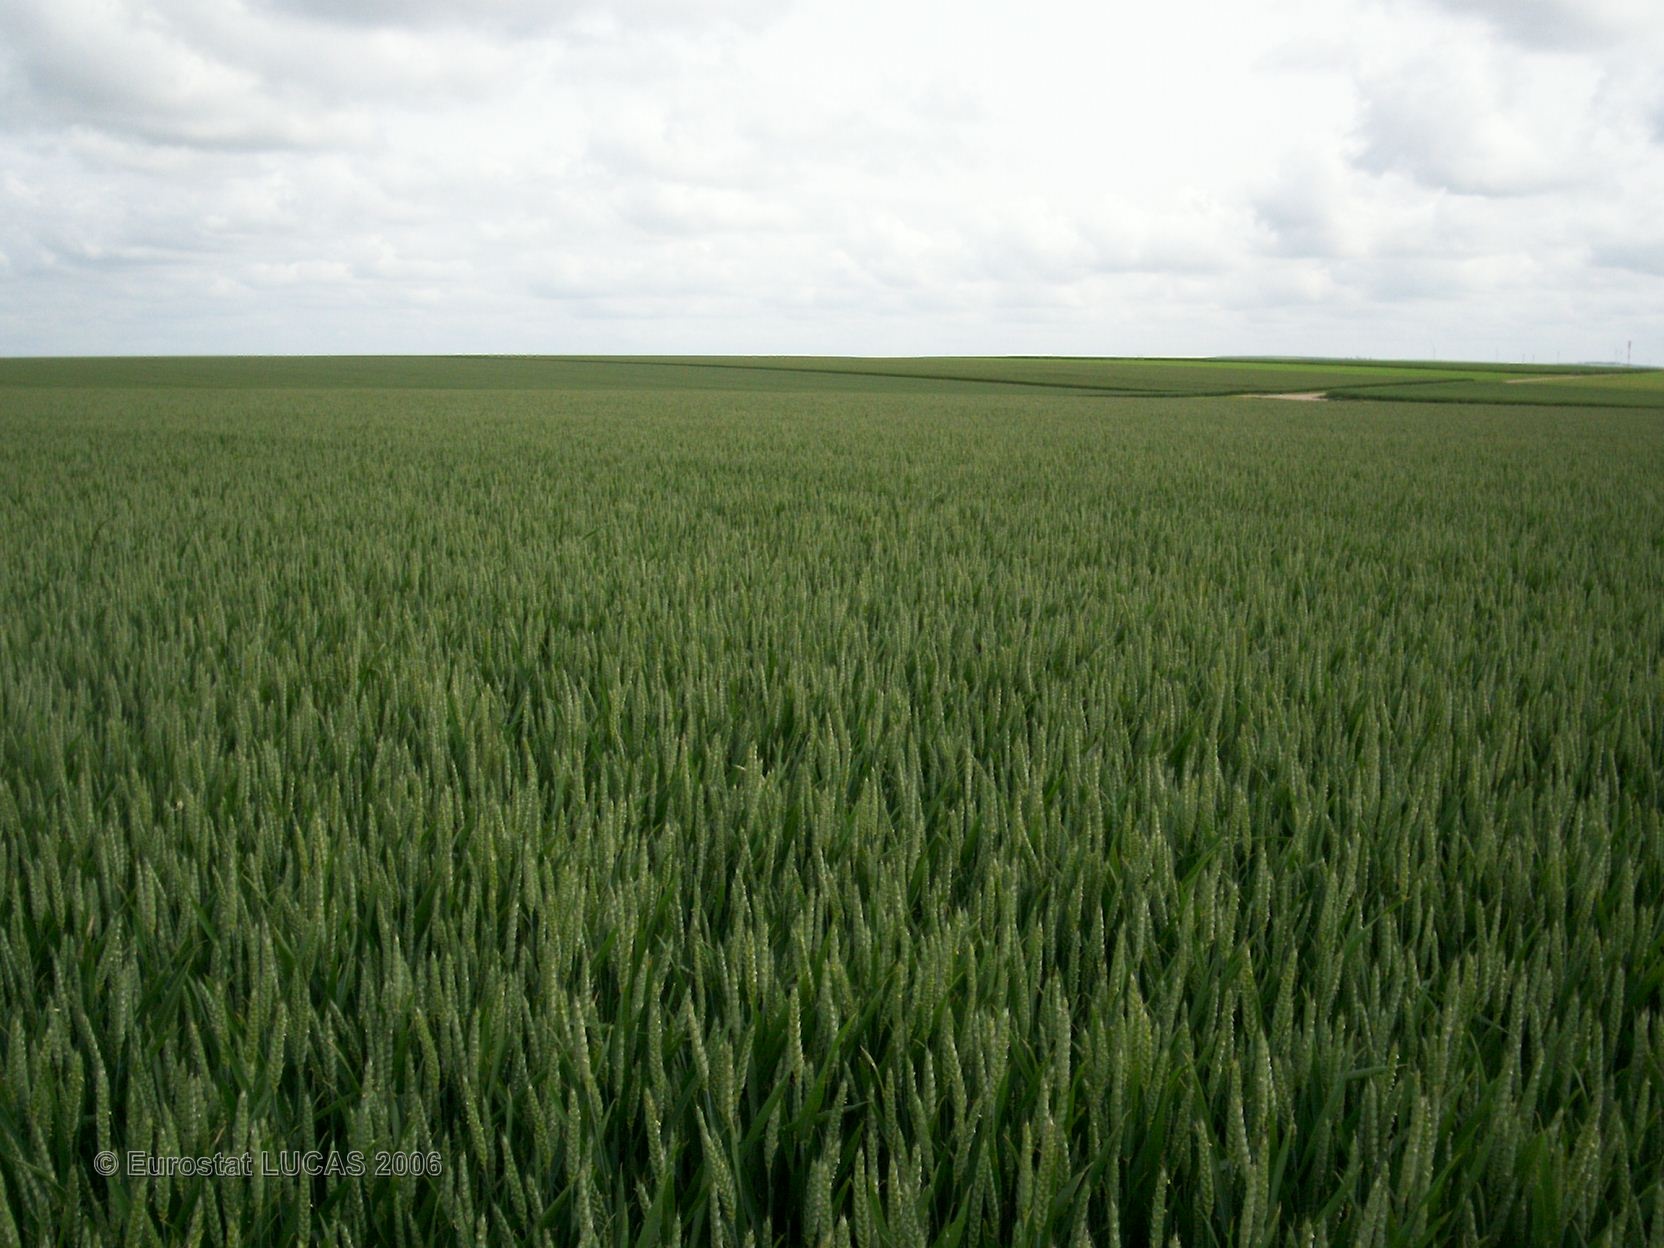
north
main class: Cropland
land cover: Common wheat
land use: Agriculture (excluding fallow land and kitchen gardens)
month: June
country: FR
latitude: 48.3469
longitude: 3.9645
